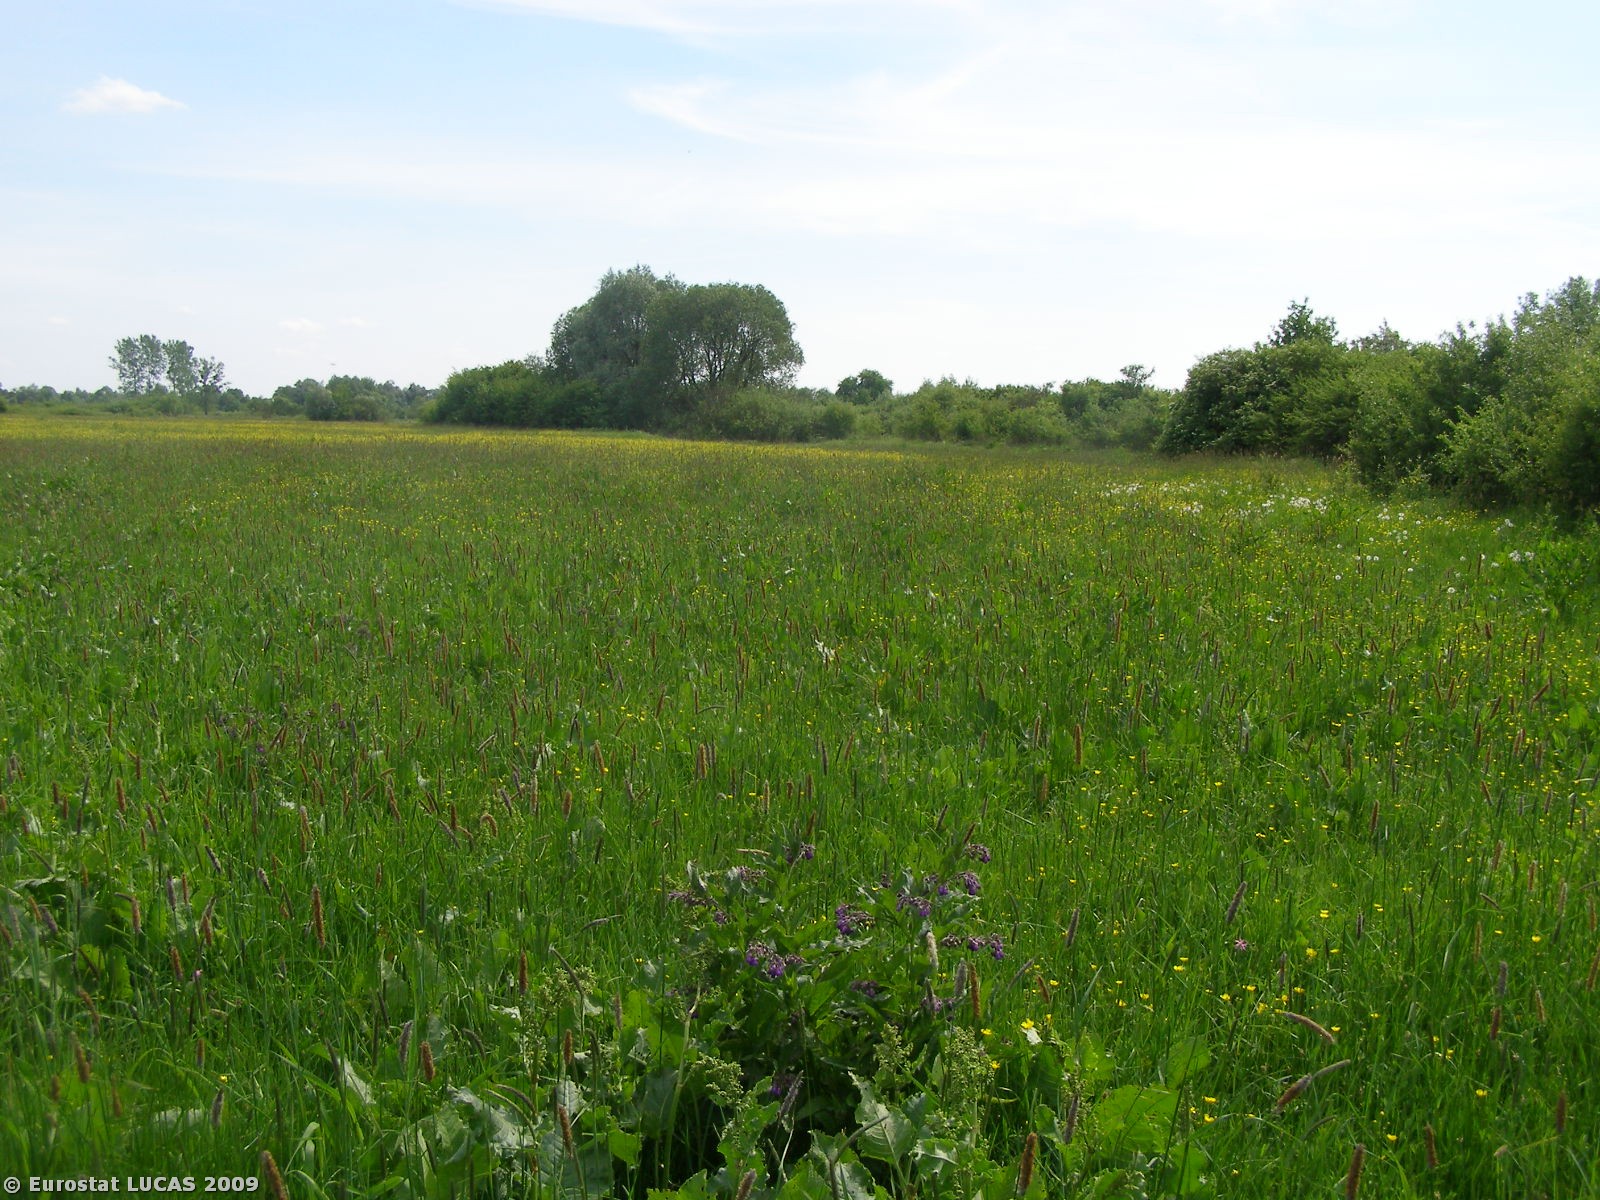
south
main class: Grassland
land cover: Grassland without tree/shrub cover
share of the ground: > 75 %
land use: Agriculture (excluding fallow land and kitchen gardens)
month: May
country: PL
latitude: 51.1399
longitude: 23.8554
